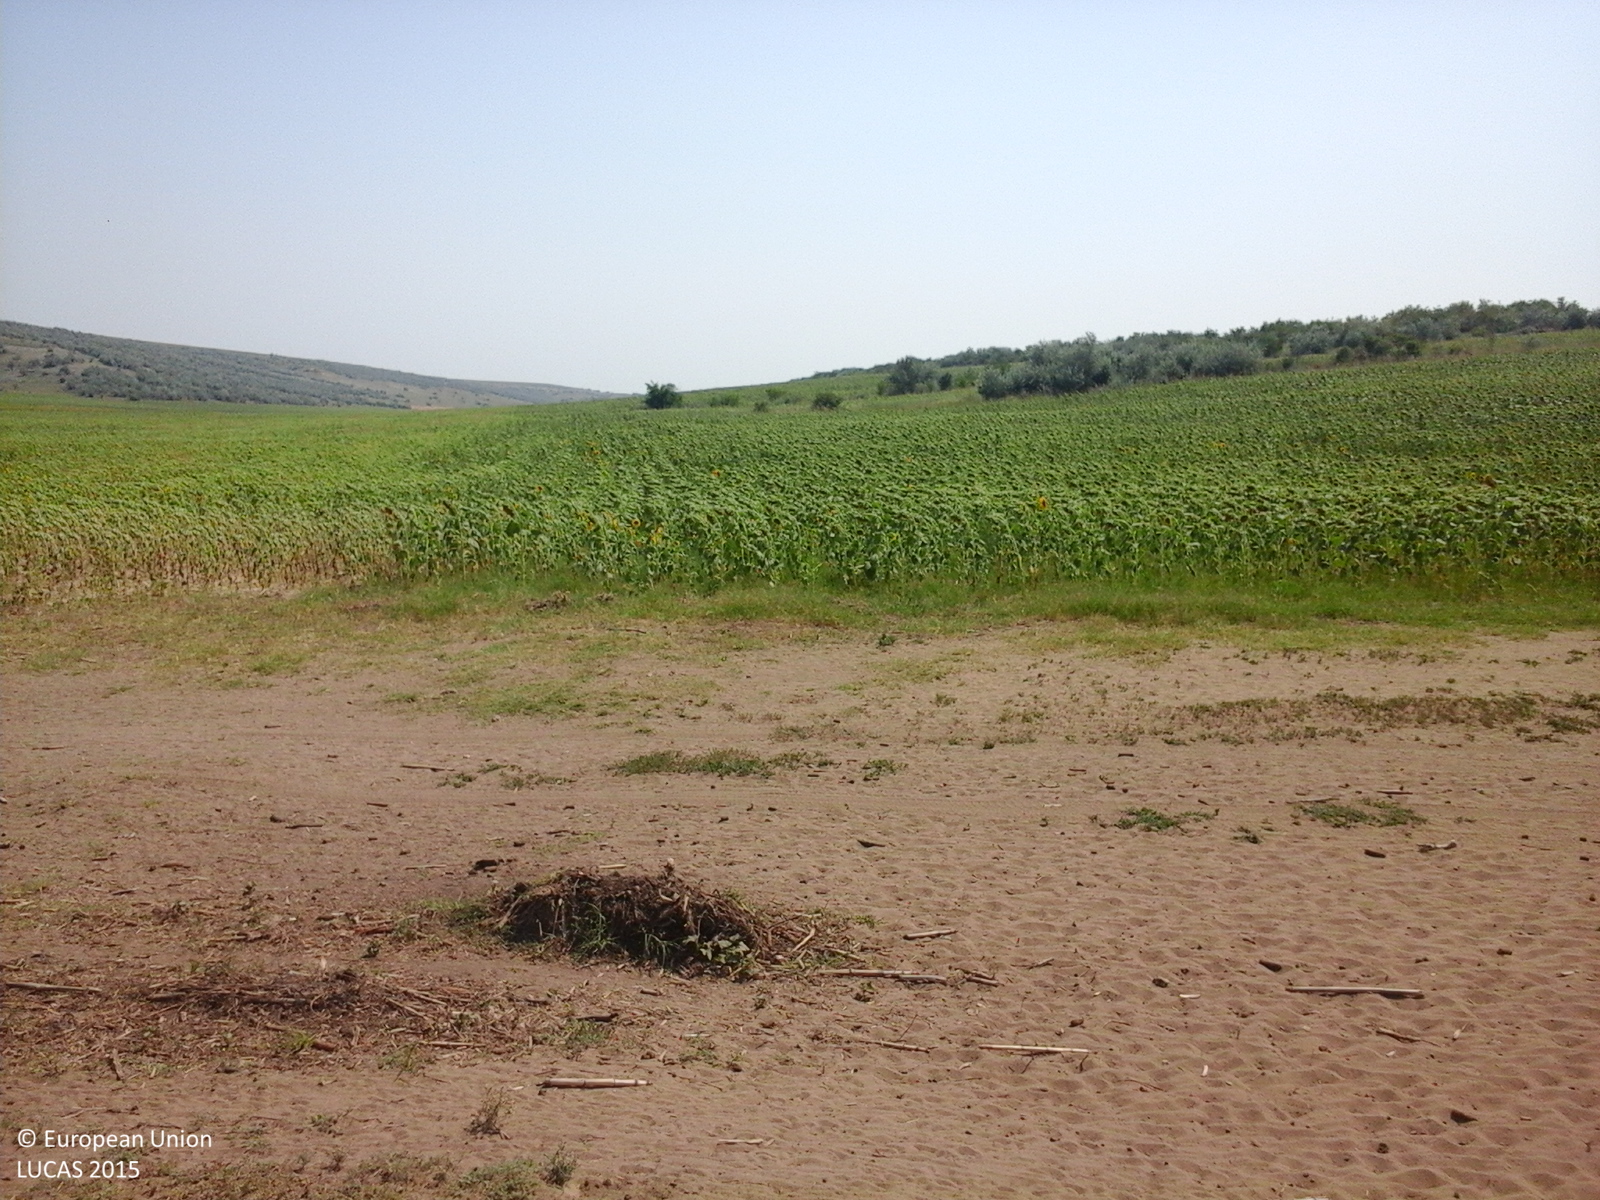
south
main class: Grassland
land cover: Spontaneously vegetated surfaces
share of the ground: > 75 %
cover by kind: herbaceous plants 100 %
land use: Semi-natural and natural areas not in use
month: July
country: RO
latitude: 45.9178
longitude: 27.9781
